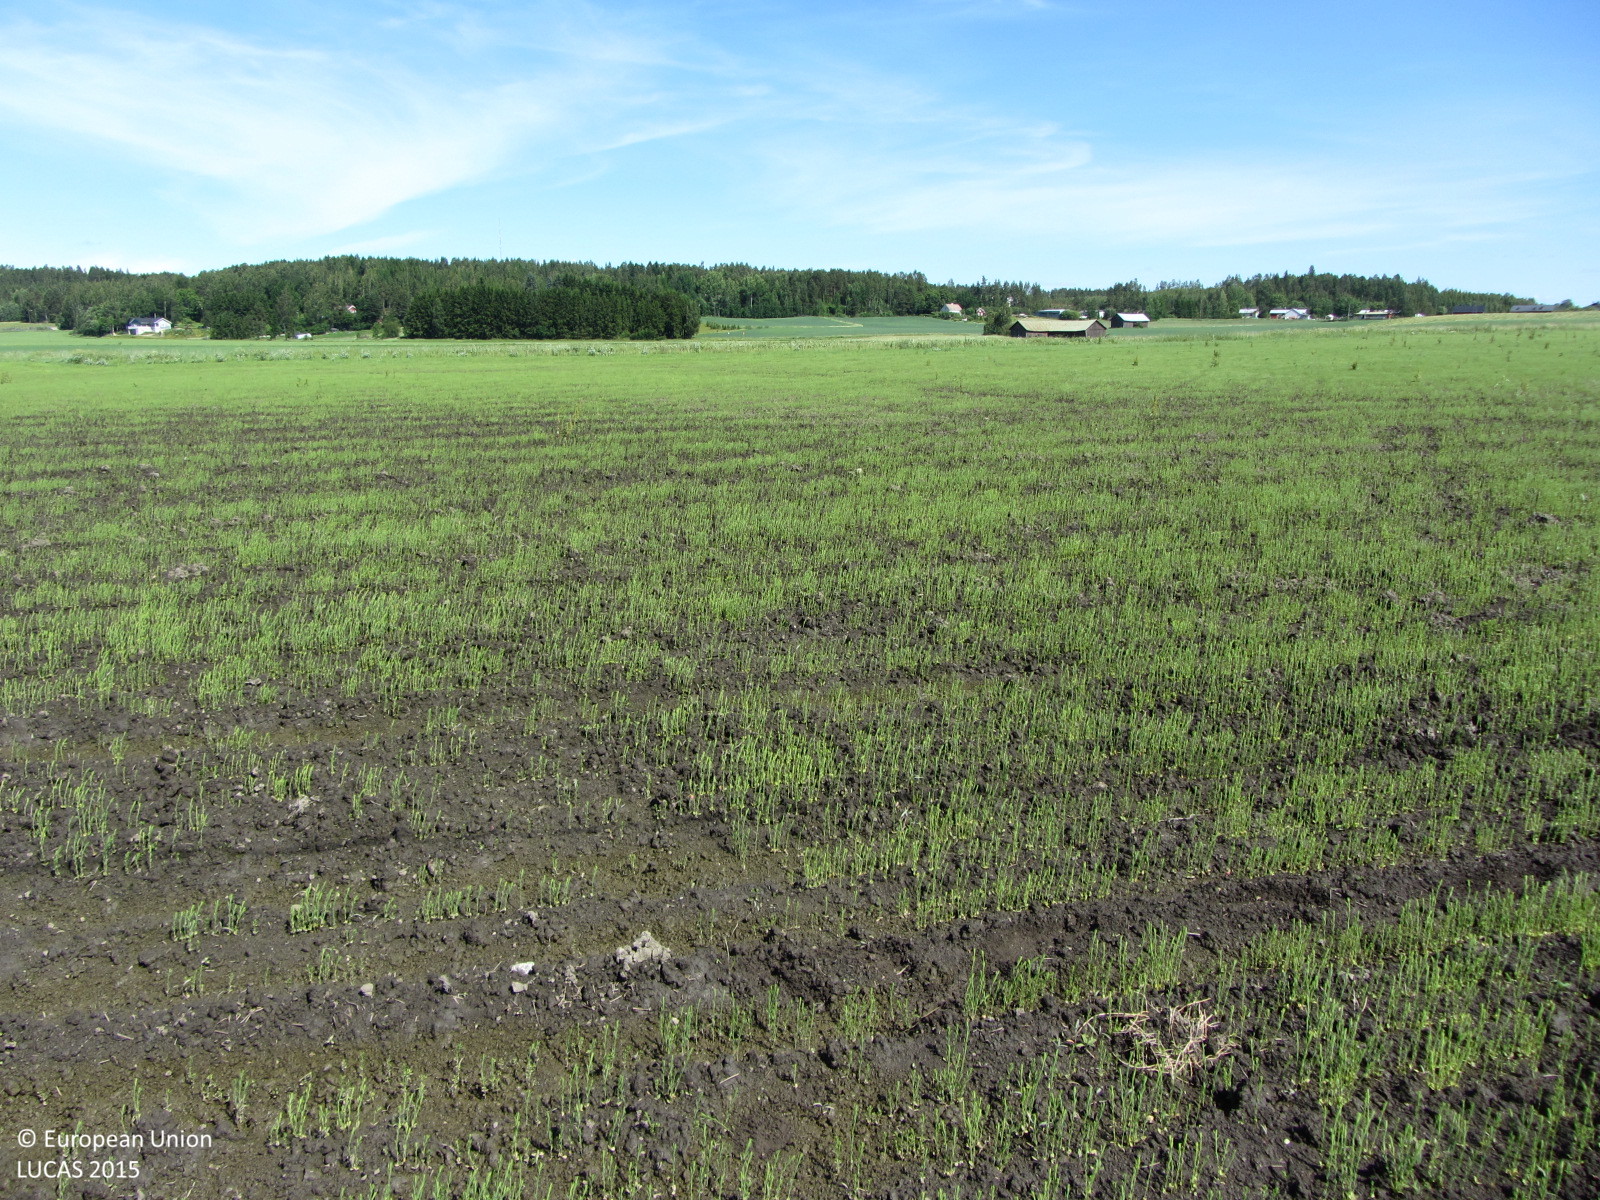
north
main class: Cropland
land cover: Other non-permanent industrial crops
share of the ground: 25 - 50 %
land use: Agriculture (excluding fallow land and kitchen gardens)
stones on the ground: < 10 %
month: June
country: FI
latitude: 60.3383
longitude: 23.2533
